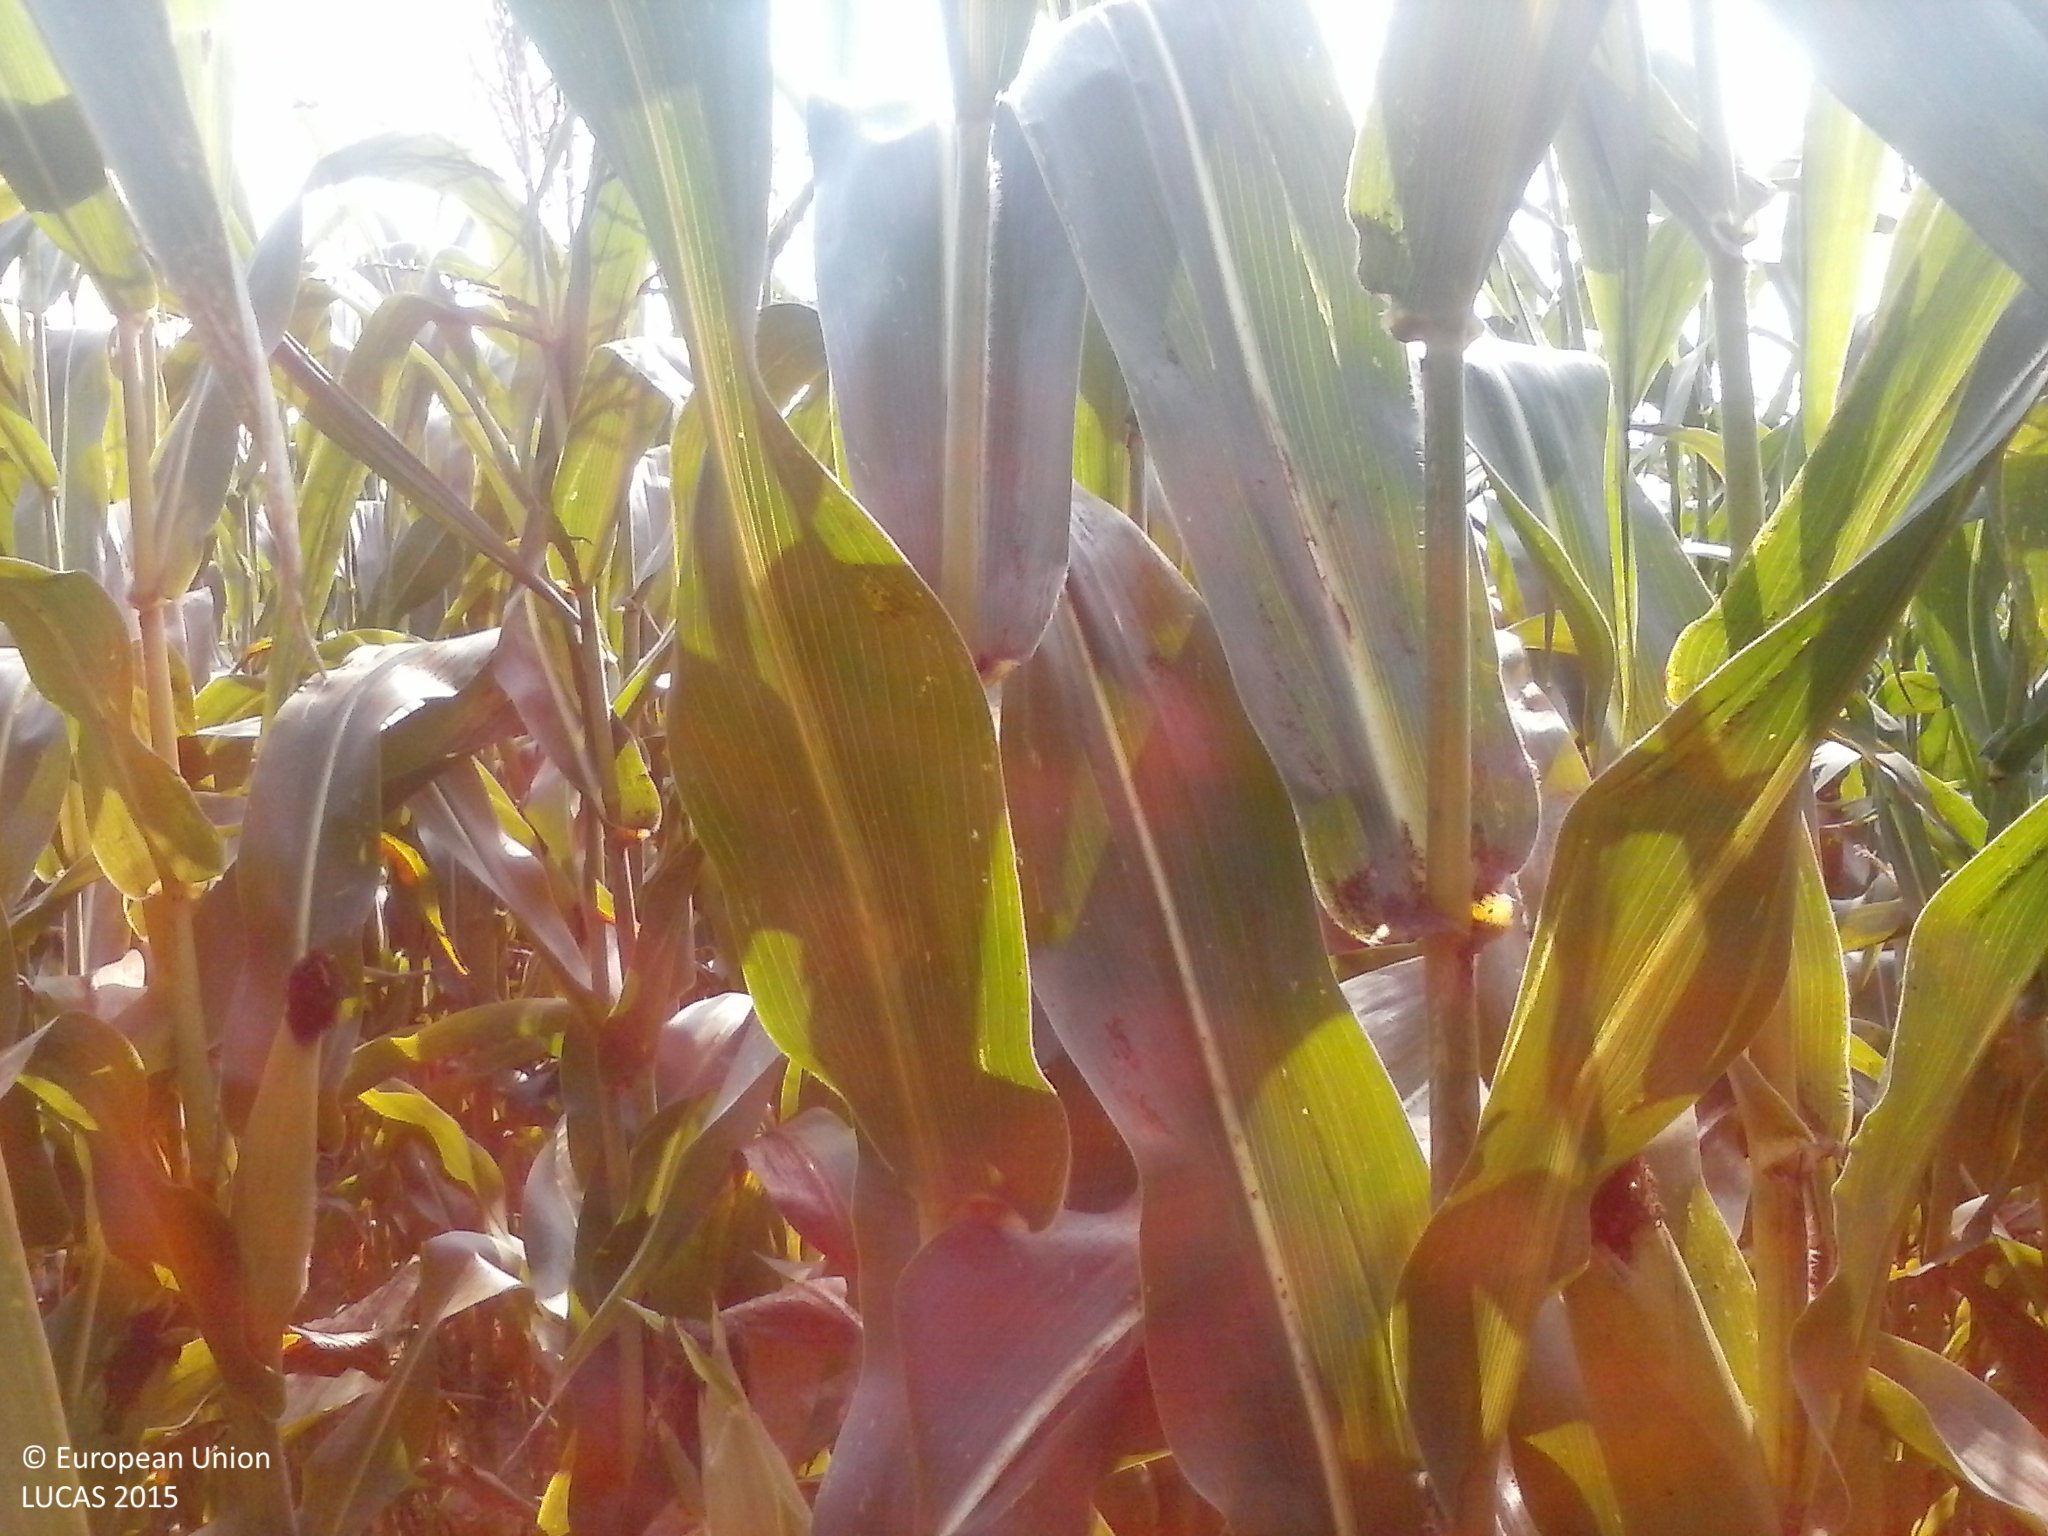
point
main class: Cropland
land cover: Maize
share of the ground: > 75 %
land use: Agriculture (excluding fallow land and kitchen gardens)
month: August
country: HU
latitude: 46.1895
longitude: 17.8443
